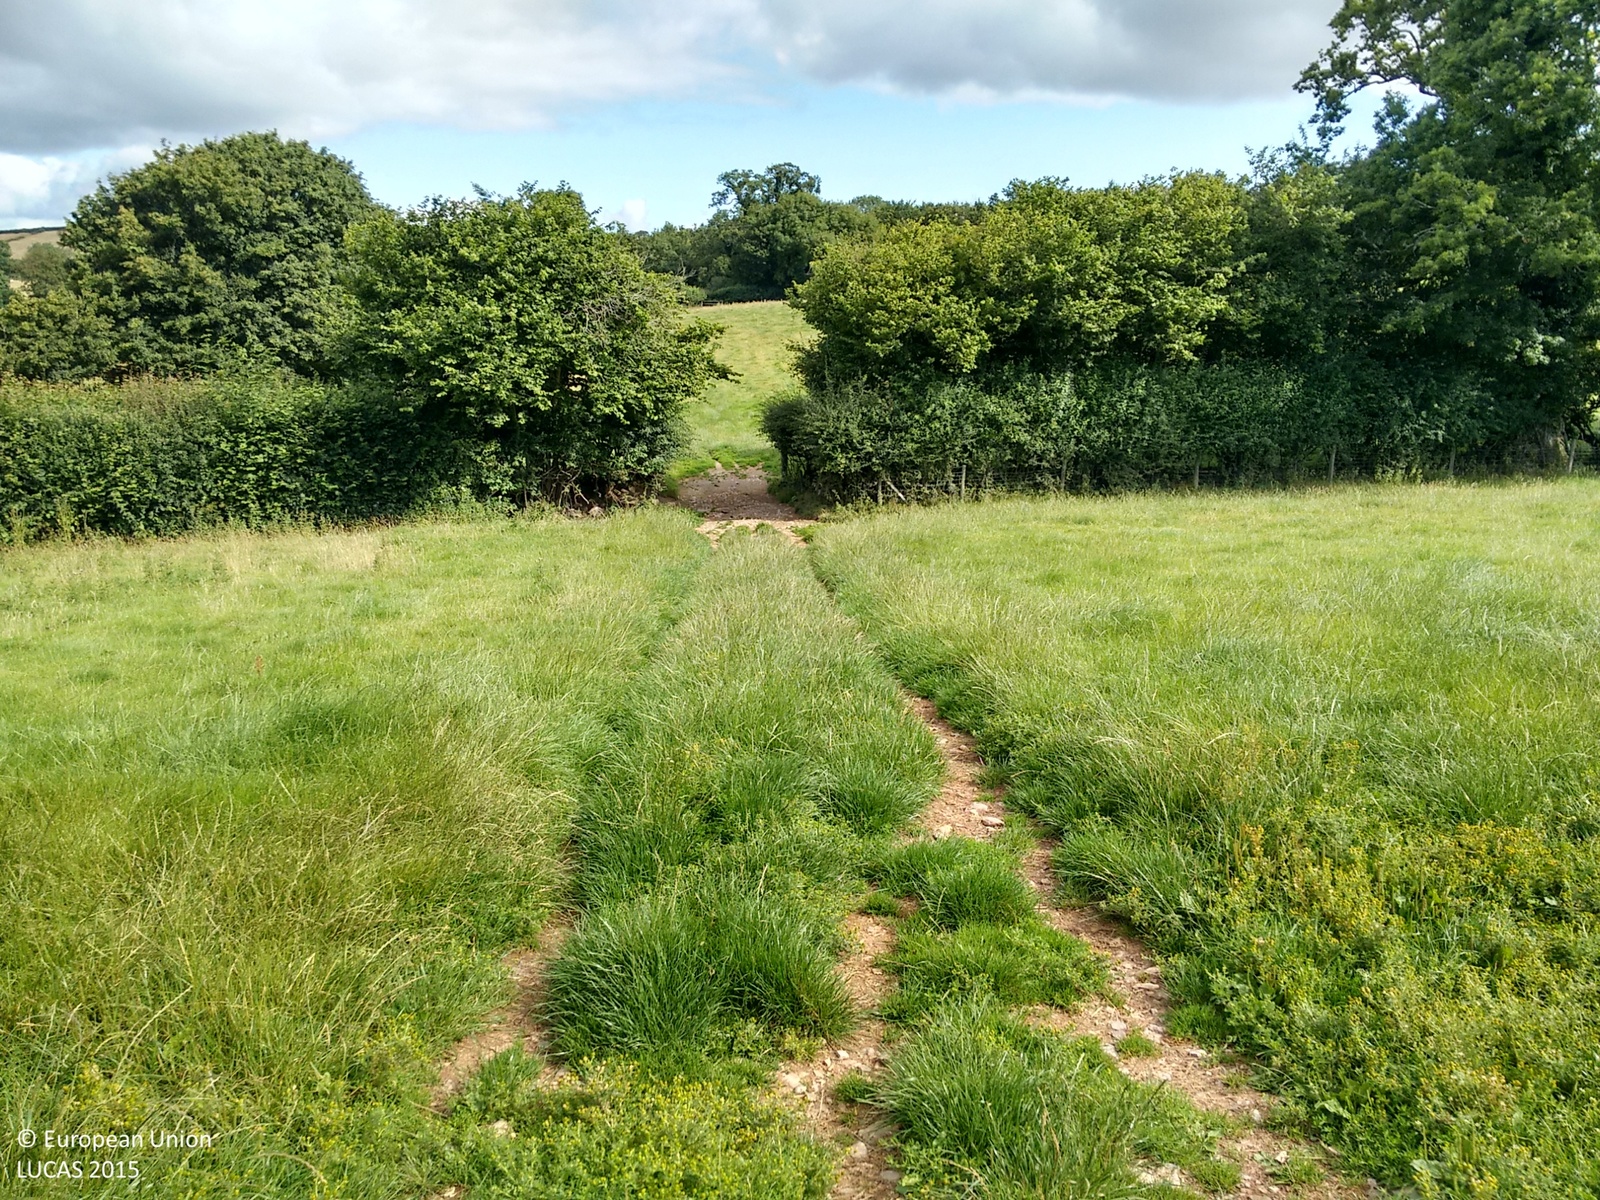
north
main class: Grassland
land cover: Grassland without tree/shrub cover
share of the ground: > 75 %
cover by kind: herbaceous plants 100 %
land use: Agriculture (excluding fallow land and kitchen gardens)
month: July
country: GB
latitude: 50.4530
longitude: -3.6497
